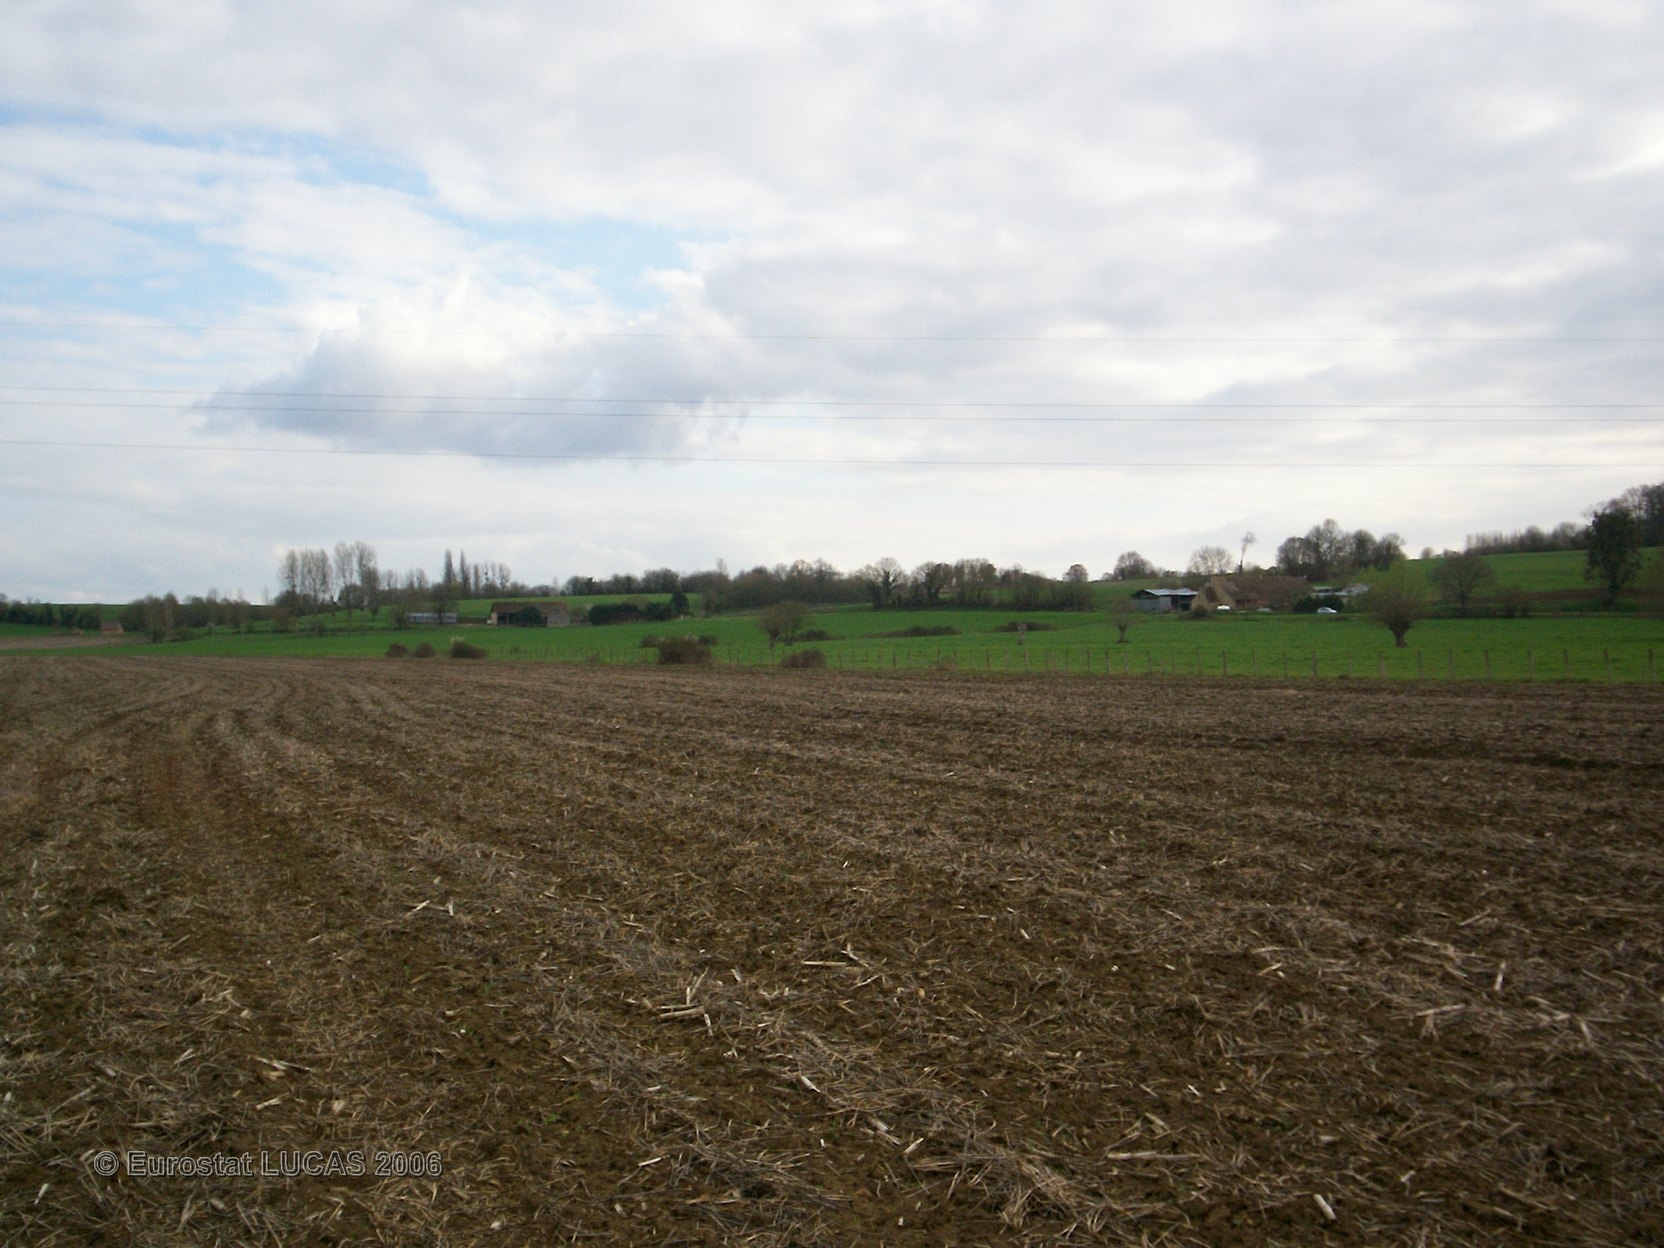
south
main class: Cropland
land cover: Maize
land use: Agriculture (excluding fallow land and kitchen gardens)
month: May
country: FR
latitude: 48.1984
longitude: 0.3550
